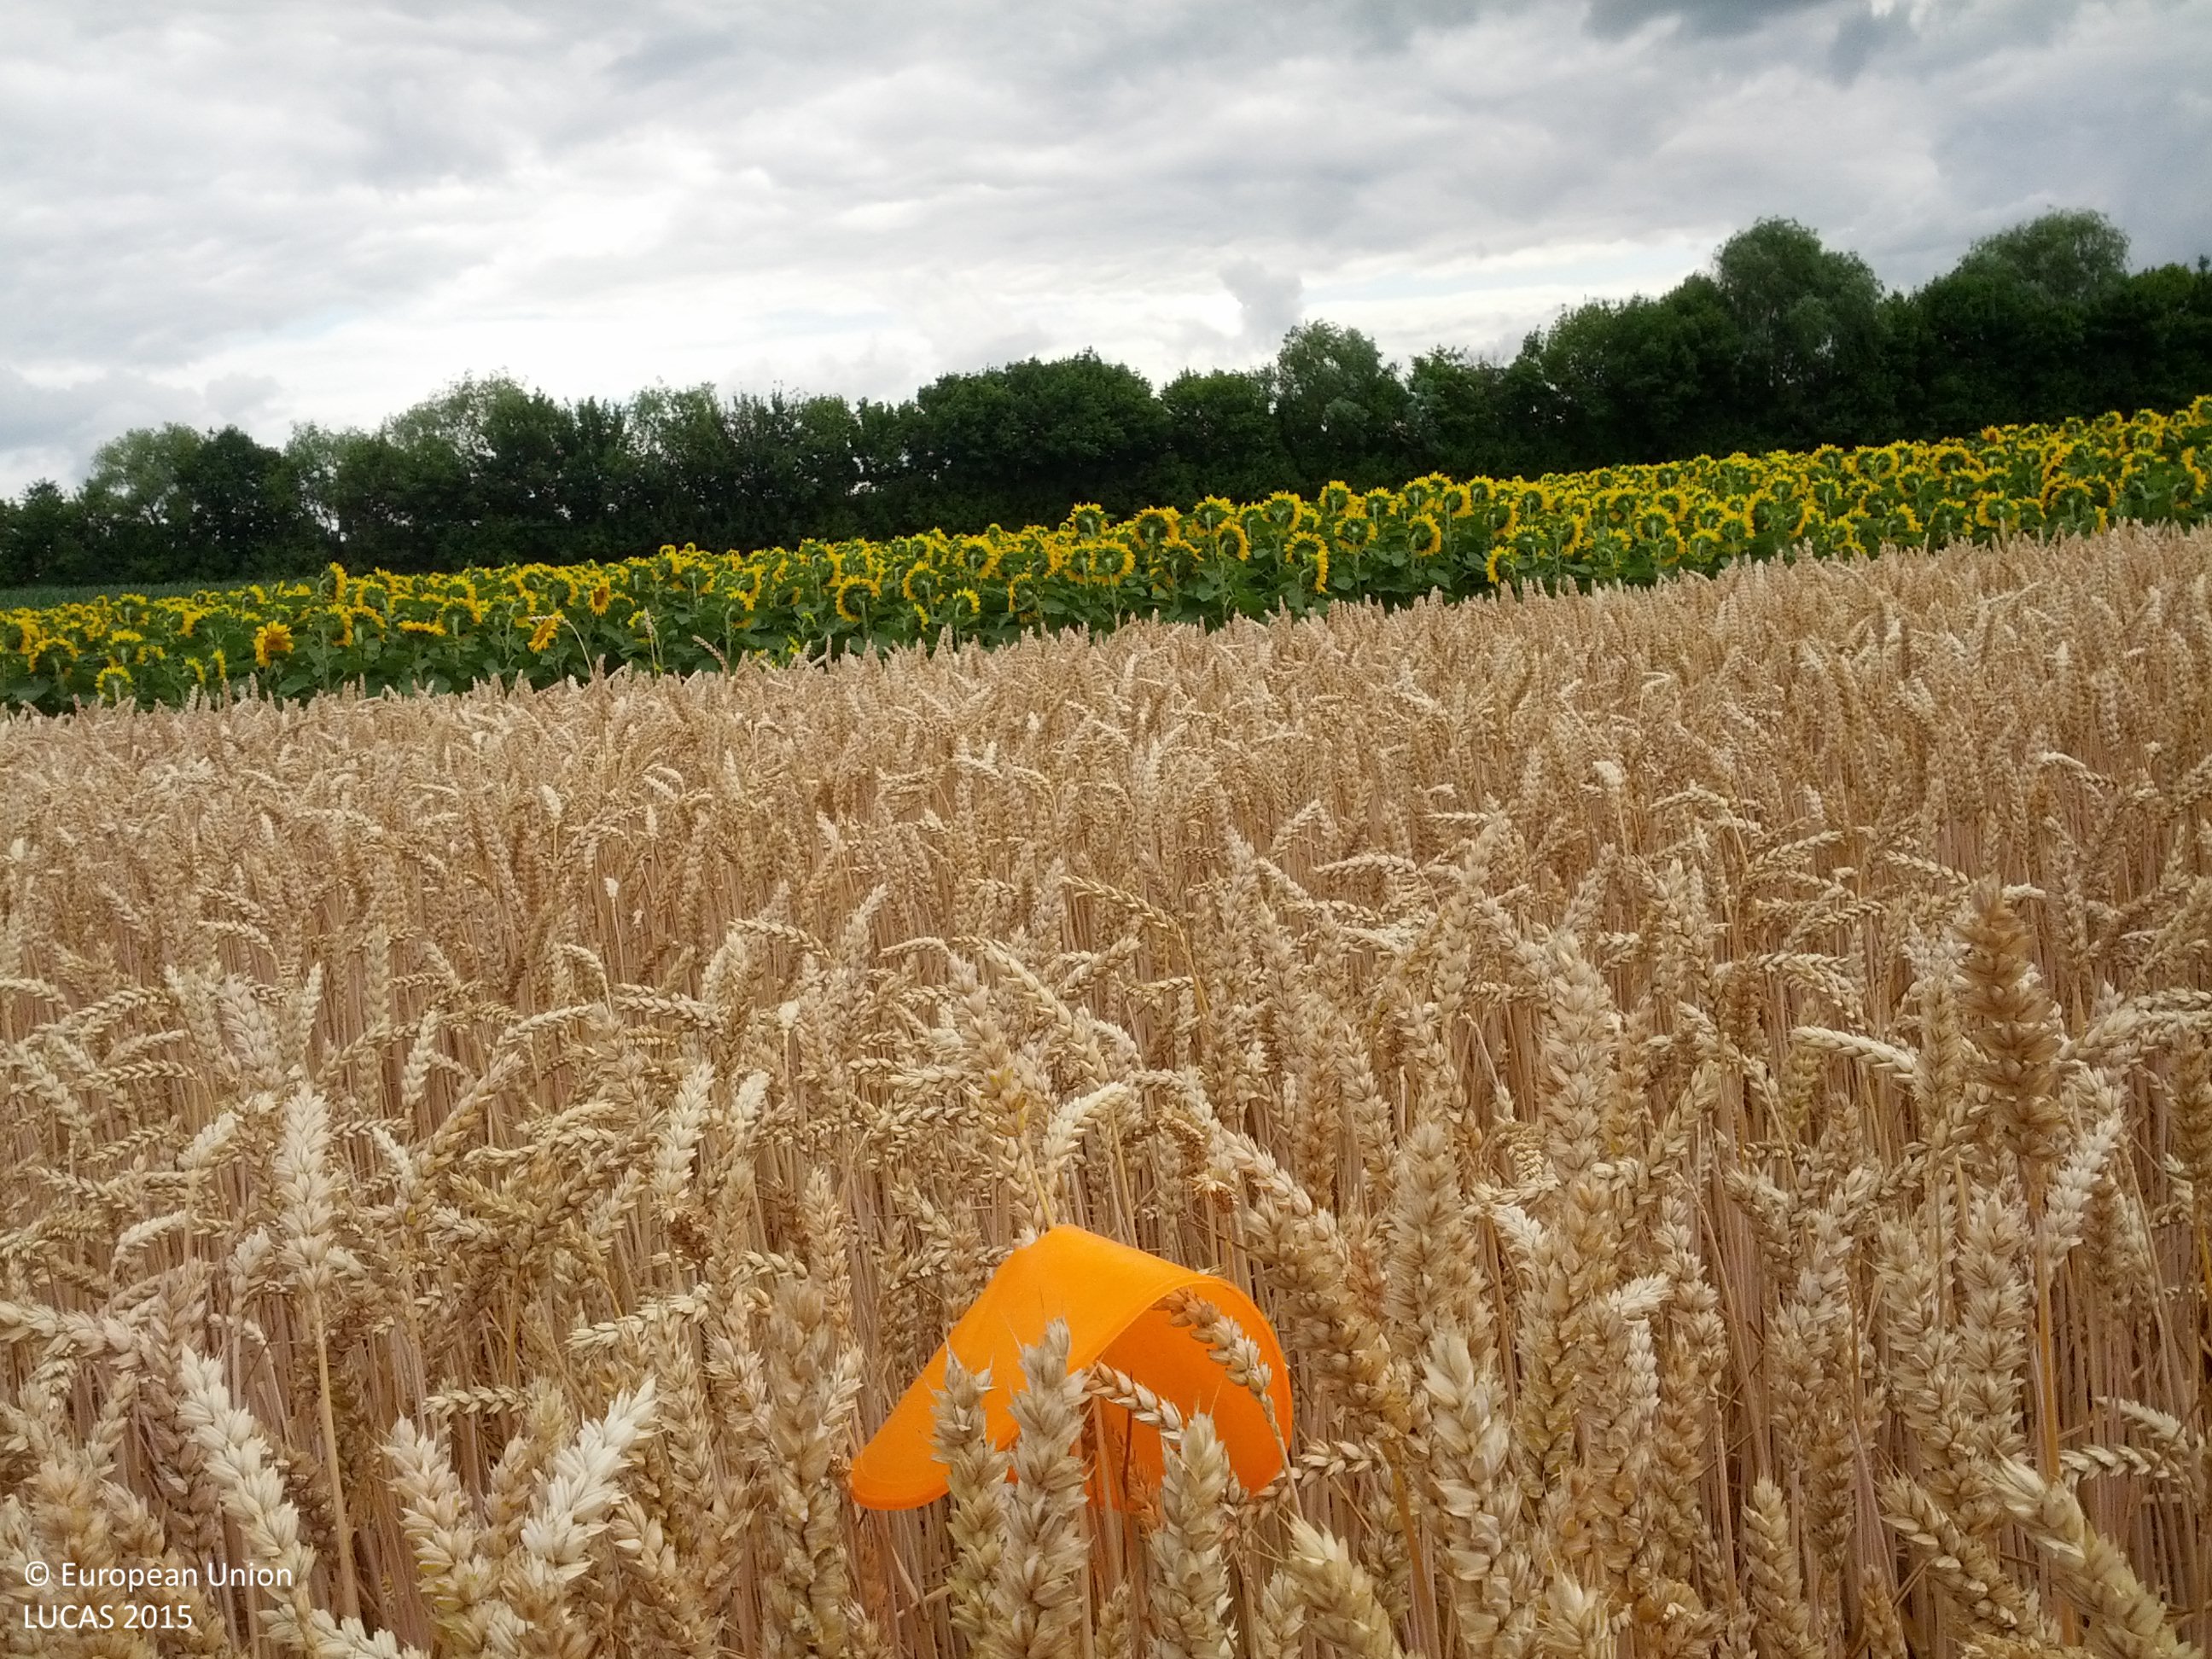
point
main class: Cropland
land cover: Common wheat
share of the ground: > 75 %
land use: Agriculture (excluding fallow land and kitchen gardens)
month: July
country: AT
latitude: 48.7166
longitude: 16.5169
